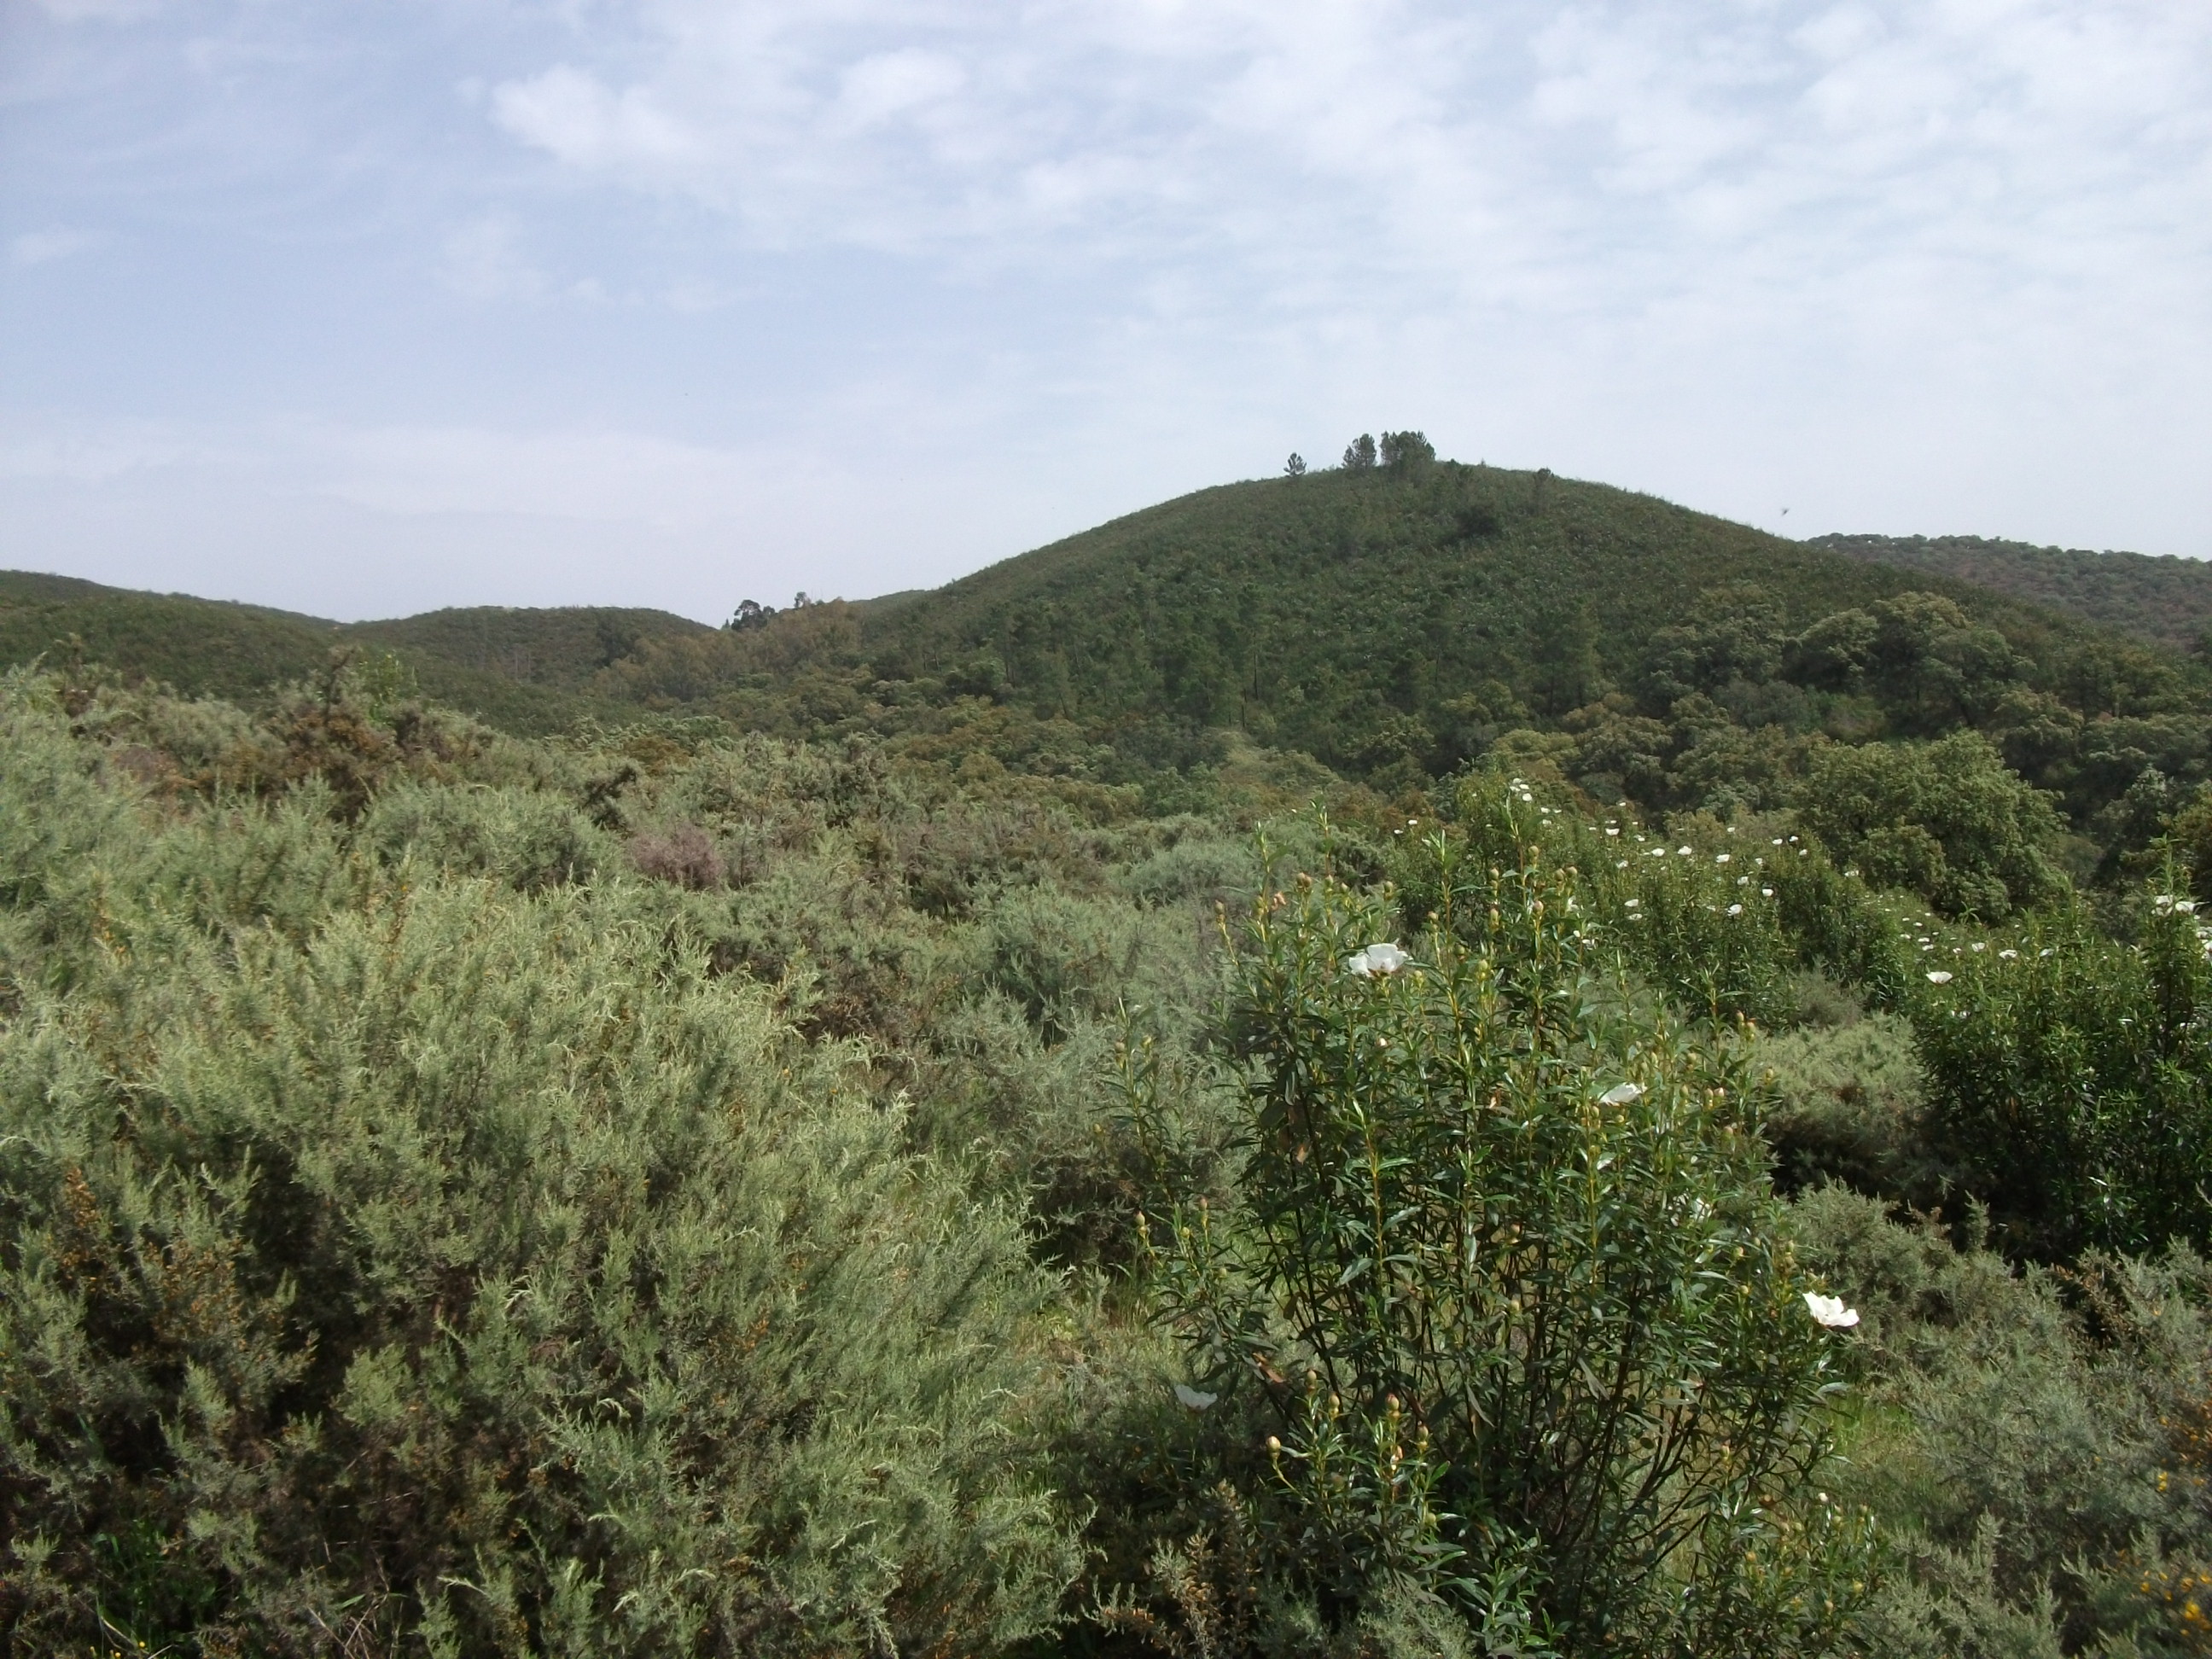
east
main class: Shrubland
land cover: Shrubland with sparse tree cover
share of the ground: > 75 %
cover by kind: shrubs 80 %, herbaceous plants 15 %, broadleaved forest trees 5 %
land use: Agriculture (excluding fallow land and kitchen gardens)
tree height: > 5 m
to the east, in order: Shrubland with sparse tree cover; Tracks; Grass margins; Rivers and streams; Grassland without tree/shrub cover; Broadleaved woodland; Shrubland without tree cover; Broadleaved woodland; Shrubland without tree cover
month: April
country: ES
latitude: 37.8265
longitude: -6.7119
